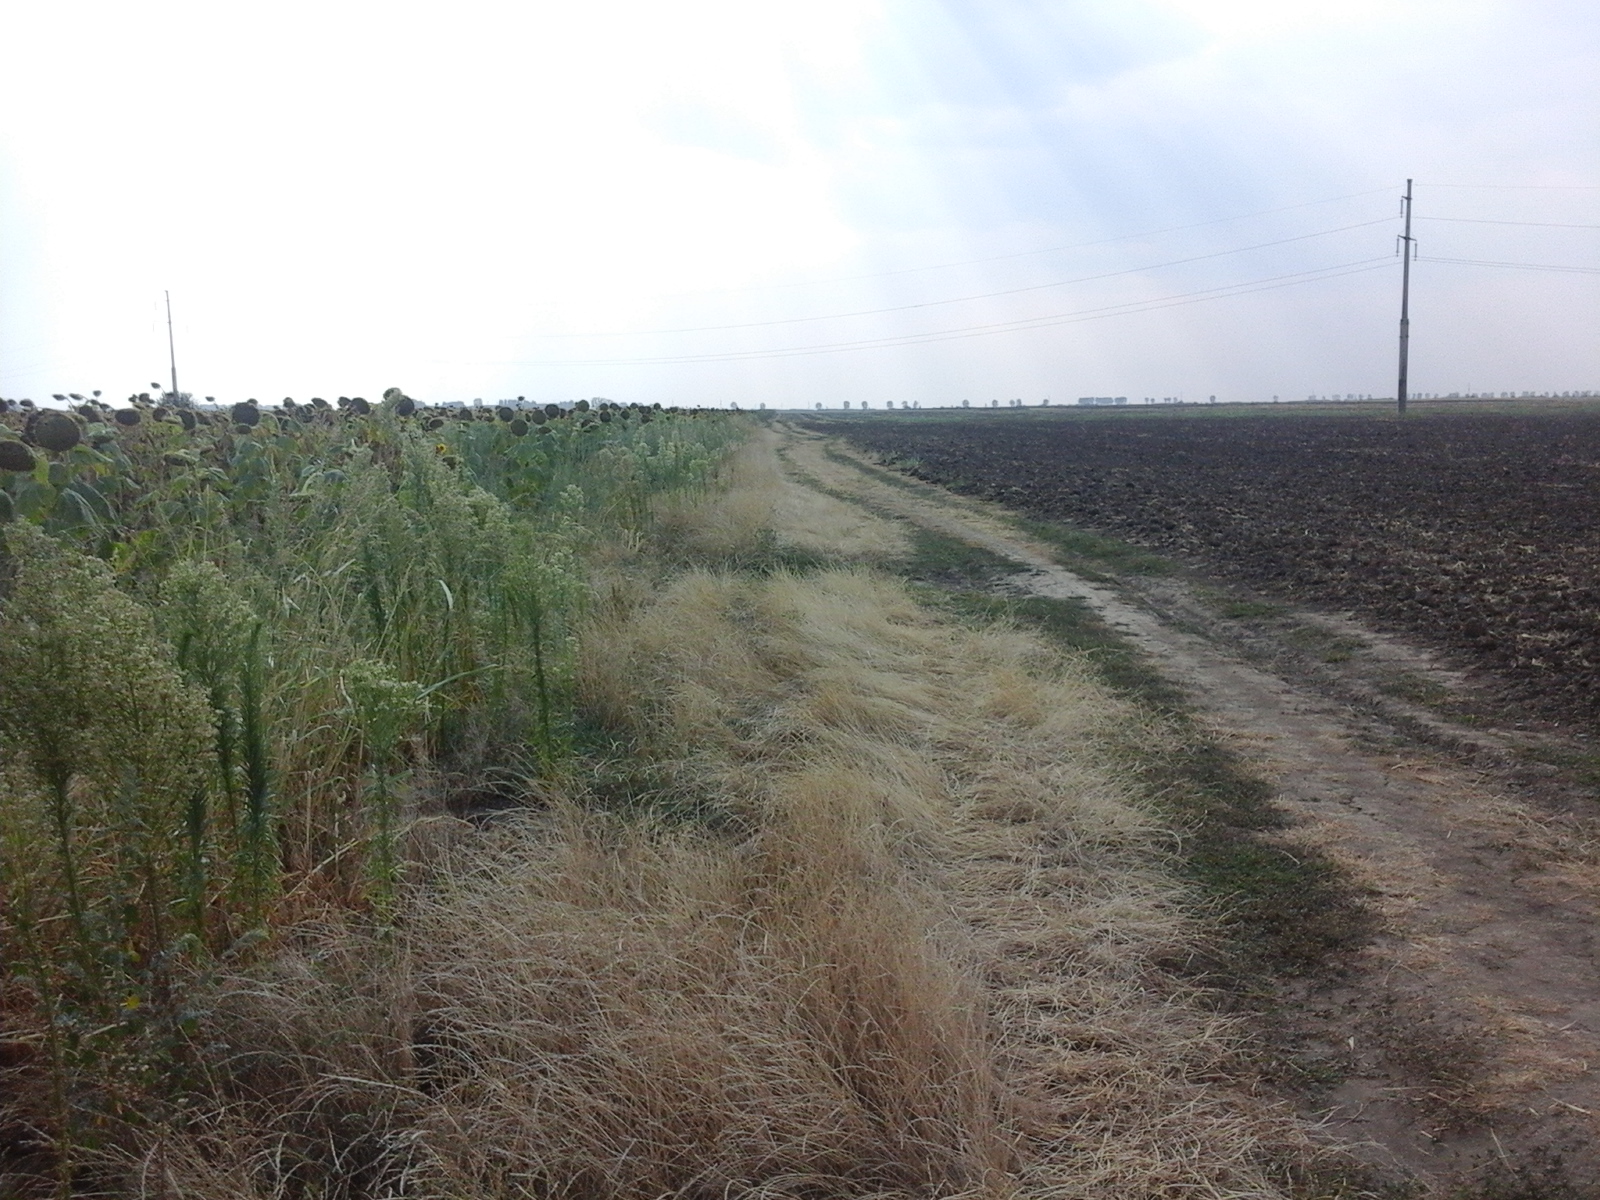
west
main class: Cropland
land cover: Sunflower
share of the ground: > 75 %
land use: Agriculture (excluding fallow land and kitchen gardens)
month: August
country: RO
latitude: 44.0446
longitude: 23.3891
